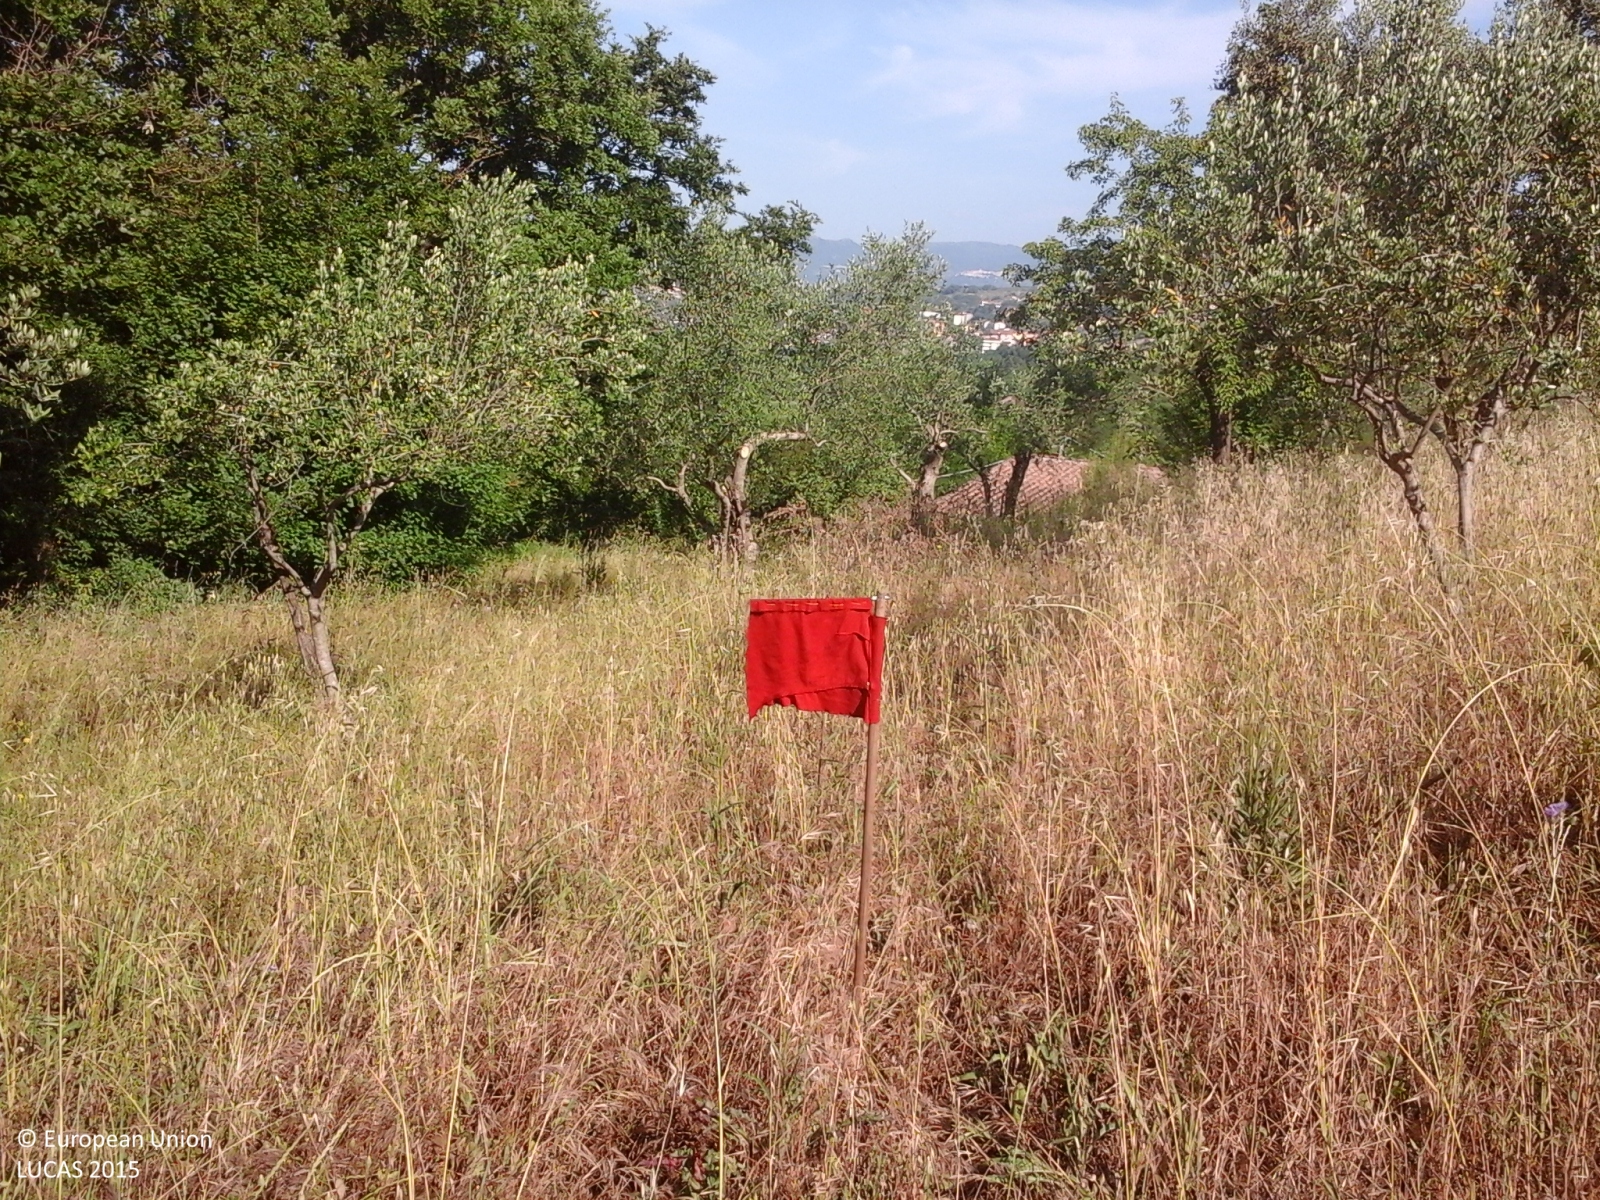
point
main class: Cropland
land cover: Olive groves
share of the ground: 25 - 50 %
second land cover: Spontaneously vegetated surfaces
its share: > 75 %
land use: Agriculture (excluding fallow land and kitchen gardens)
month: May
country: IT
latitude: 41.2048
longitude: 14.7167
